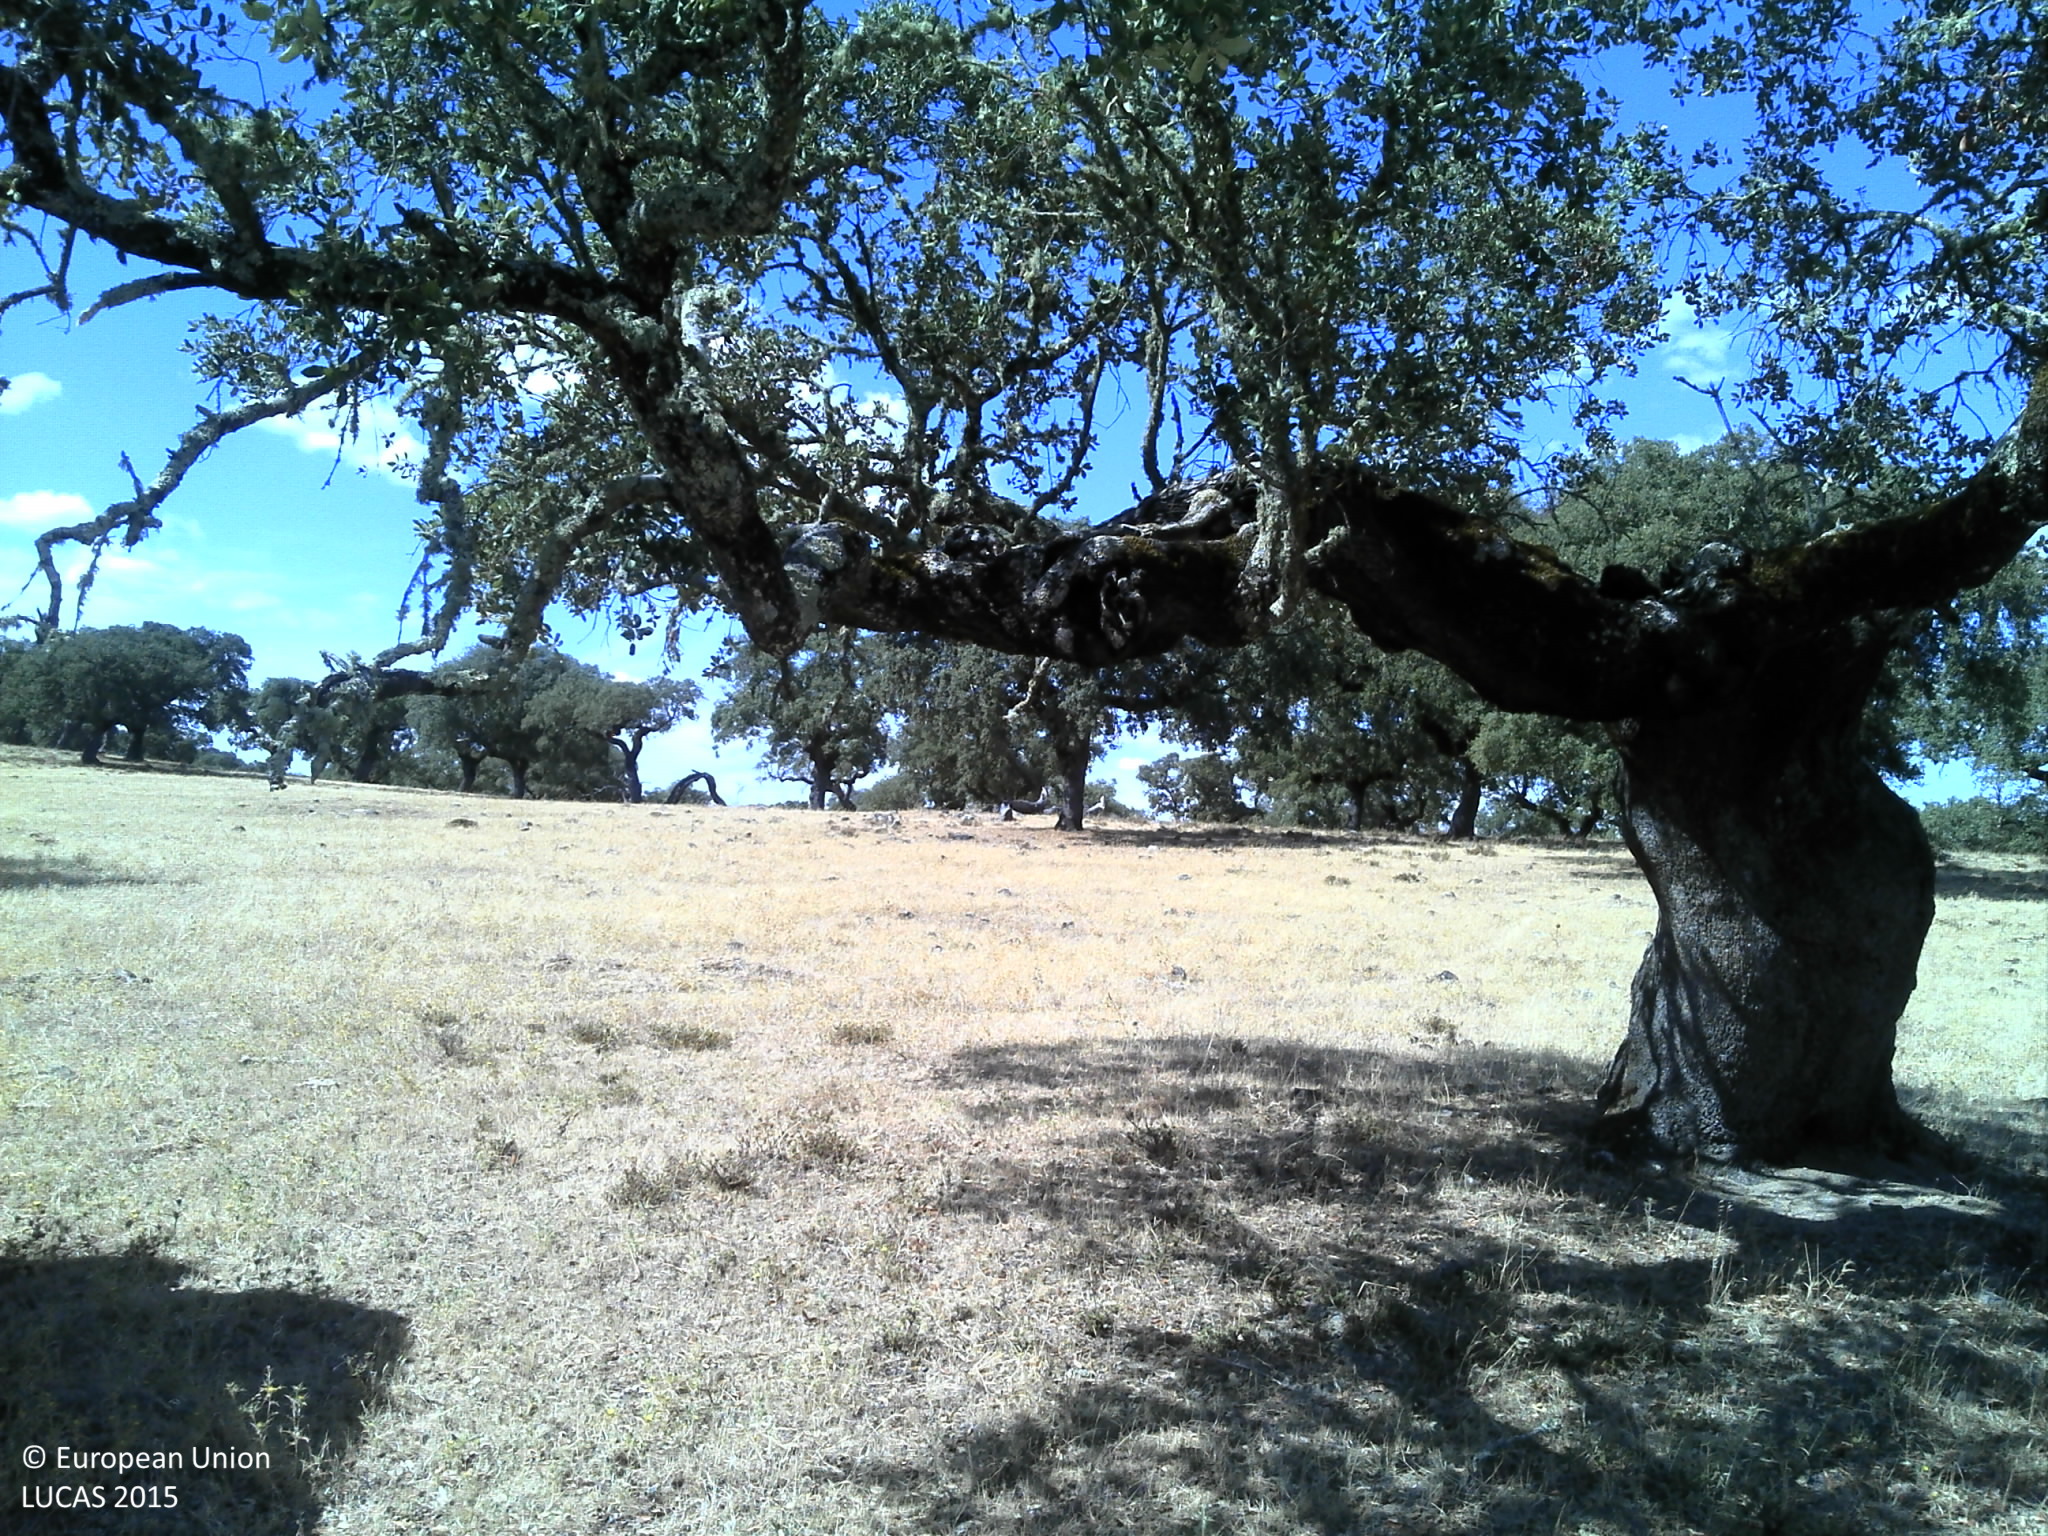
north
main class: Woodland
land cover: Broadleaved woodland
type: broadleaved evergreen forest
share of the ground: 10 - 25 %
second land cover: Grassland without tree/shrub cover
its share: 10 - 25 %
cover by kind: unconsolidated bare surface 70 %, broadleaved forest trees 15 %, herbaceous plants 15 %
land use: Forestry
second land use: Agriculture (excluding fallow land and kitchen gardens)
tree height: > 5 m
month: July
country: PT
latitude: 39.1599
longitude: -7.5041
